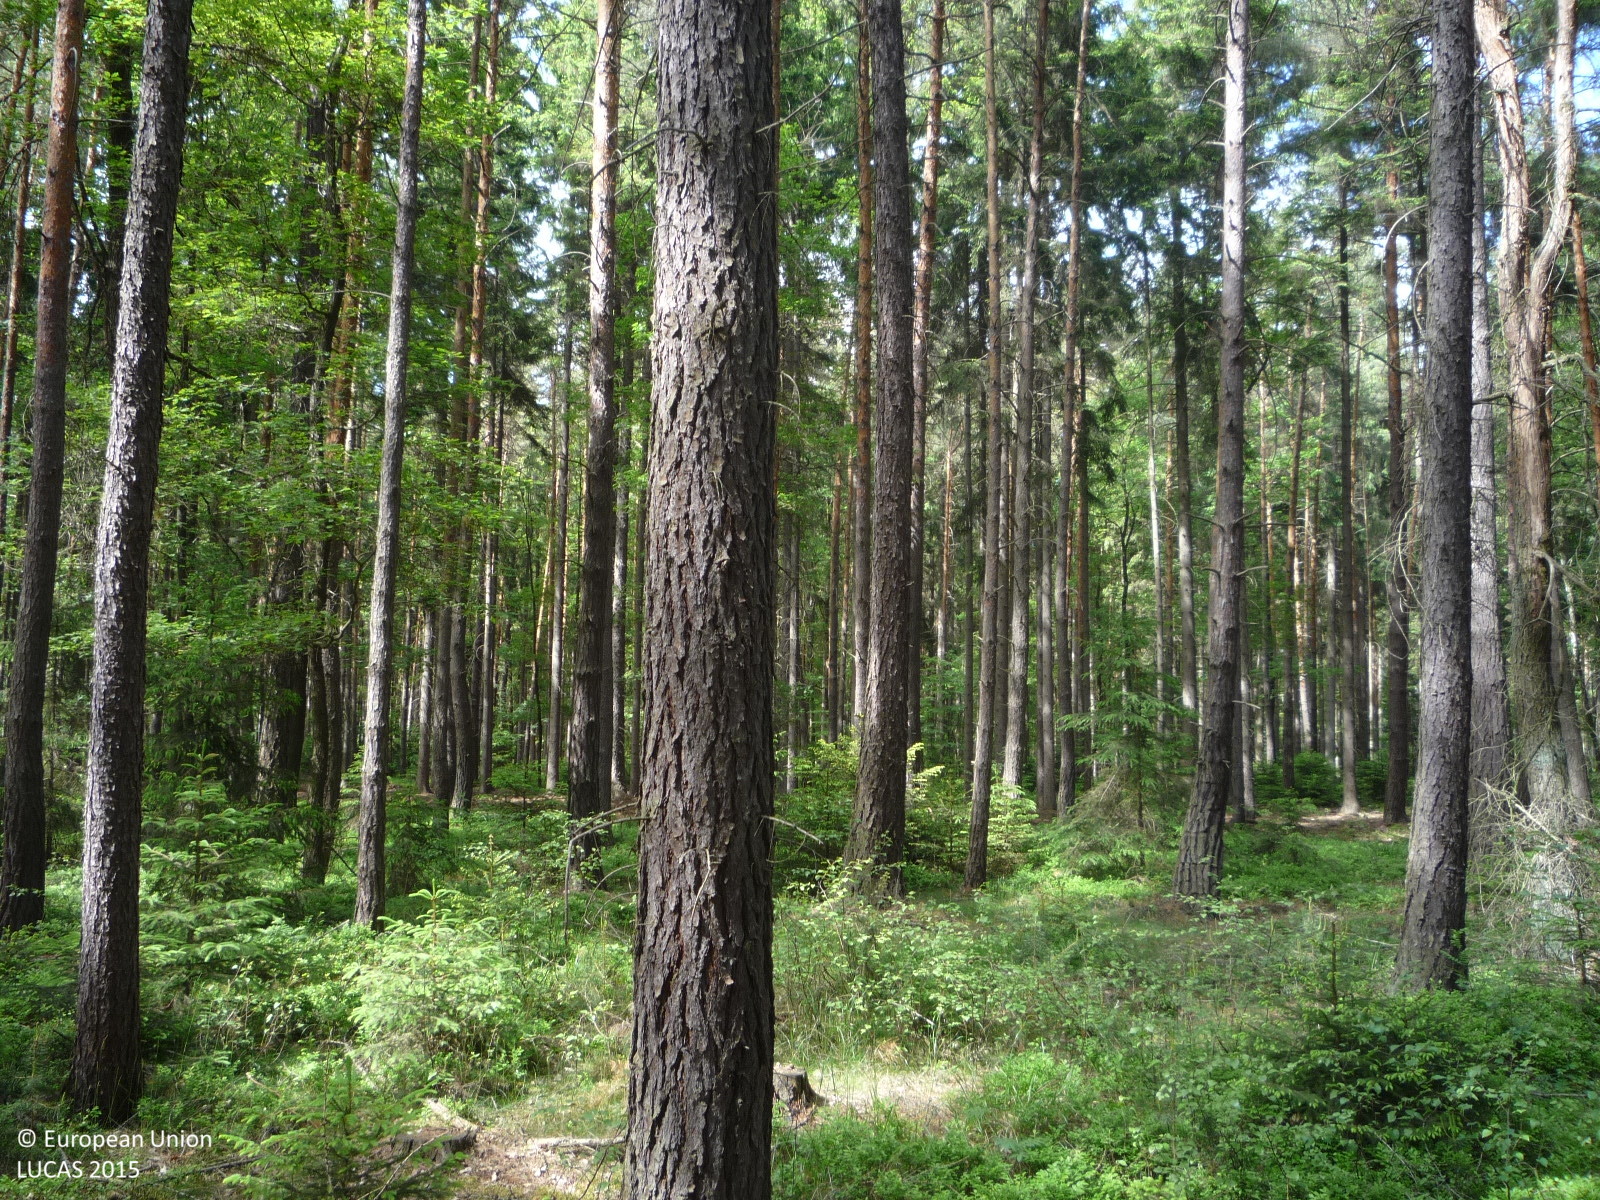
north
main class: Woodland
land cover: Pine dominated coniferous woodland
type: hemiboreal forest and nemoral coniferous forest and mixed broadleaved-coniferous forest
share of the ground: > 75 %
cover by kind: coniferous forest trees 90 %, broadleaved forest trees 10 %
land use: Forestry
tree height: > 5 m
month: June
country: CZ
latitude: 50.2450
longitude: 13.8570
